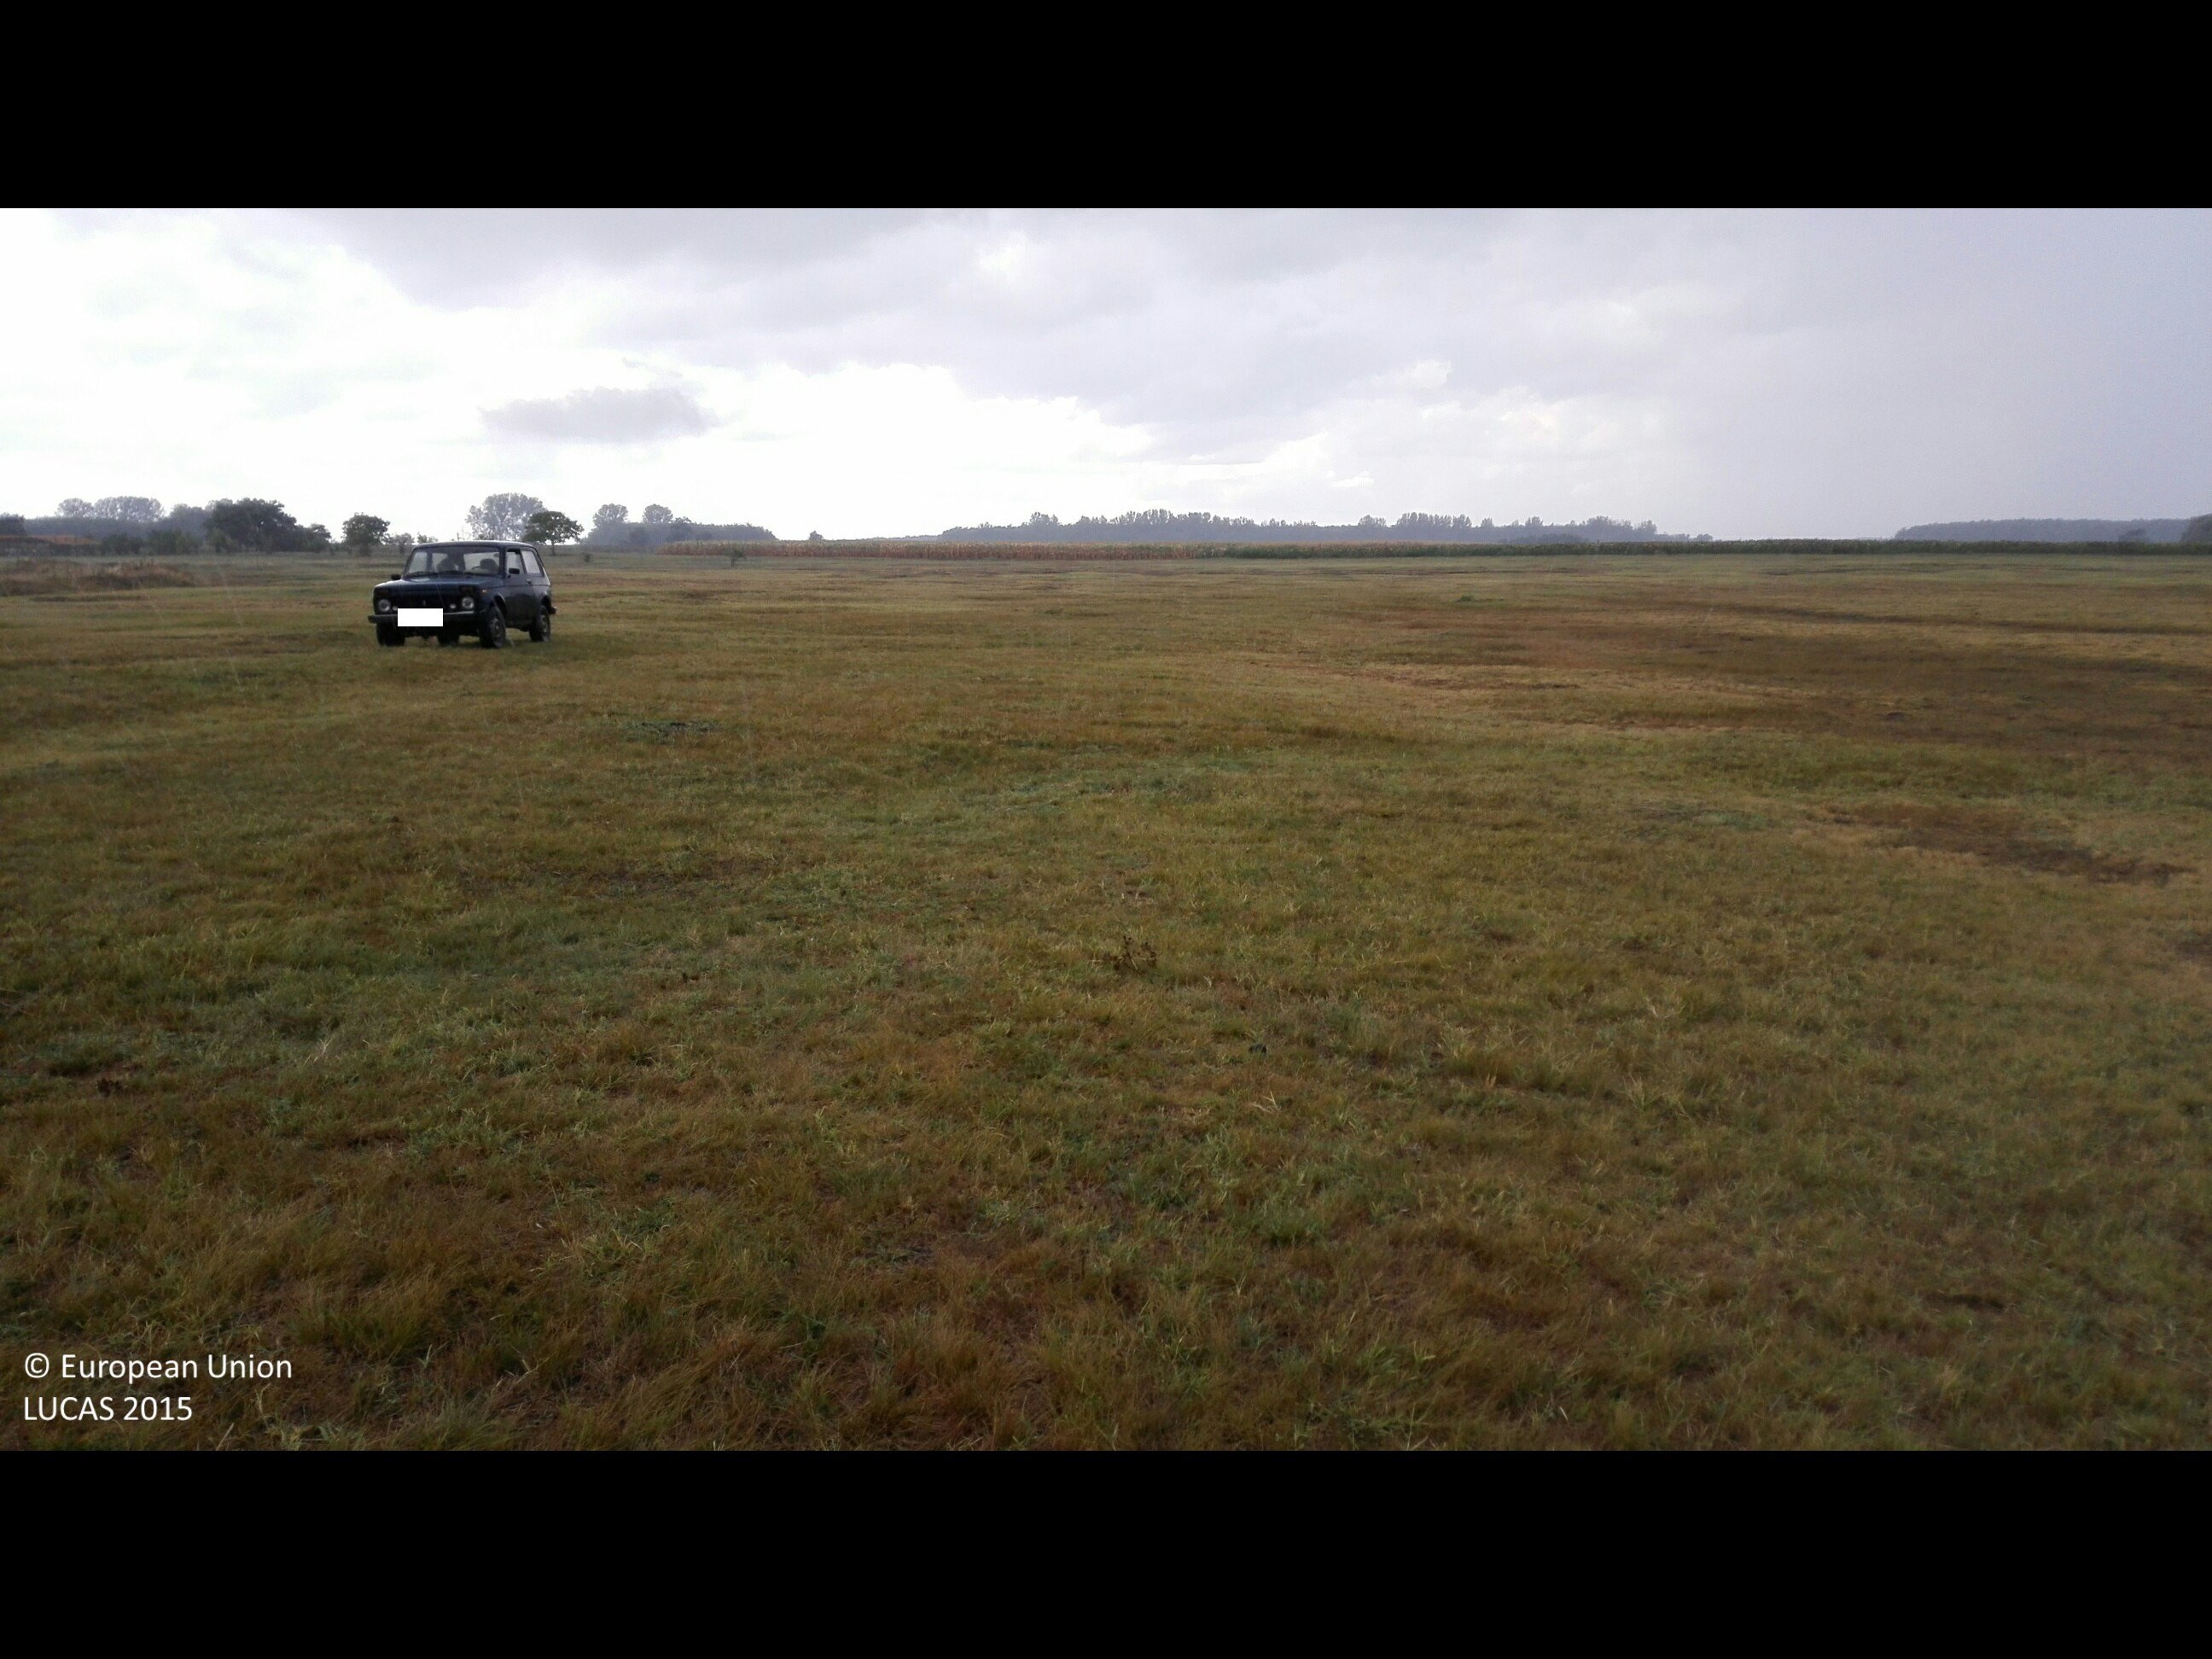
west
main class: Grassland
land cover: Grassland without tree/shrub cover
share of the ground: > 75 %
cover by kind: herbaceous plants 100 %
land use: Agriculture (excluding fallow land and kitchen gardens)
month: August
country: HU
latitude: 47.3458
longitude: 21.6794
